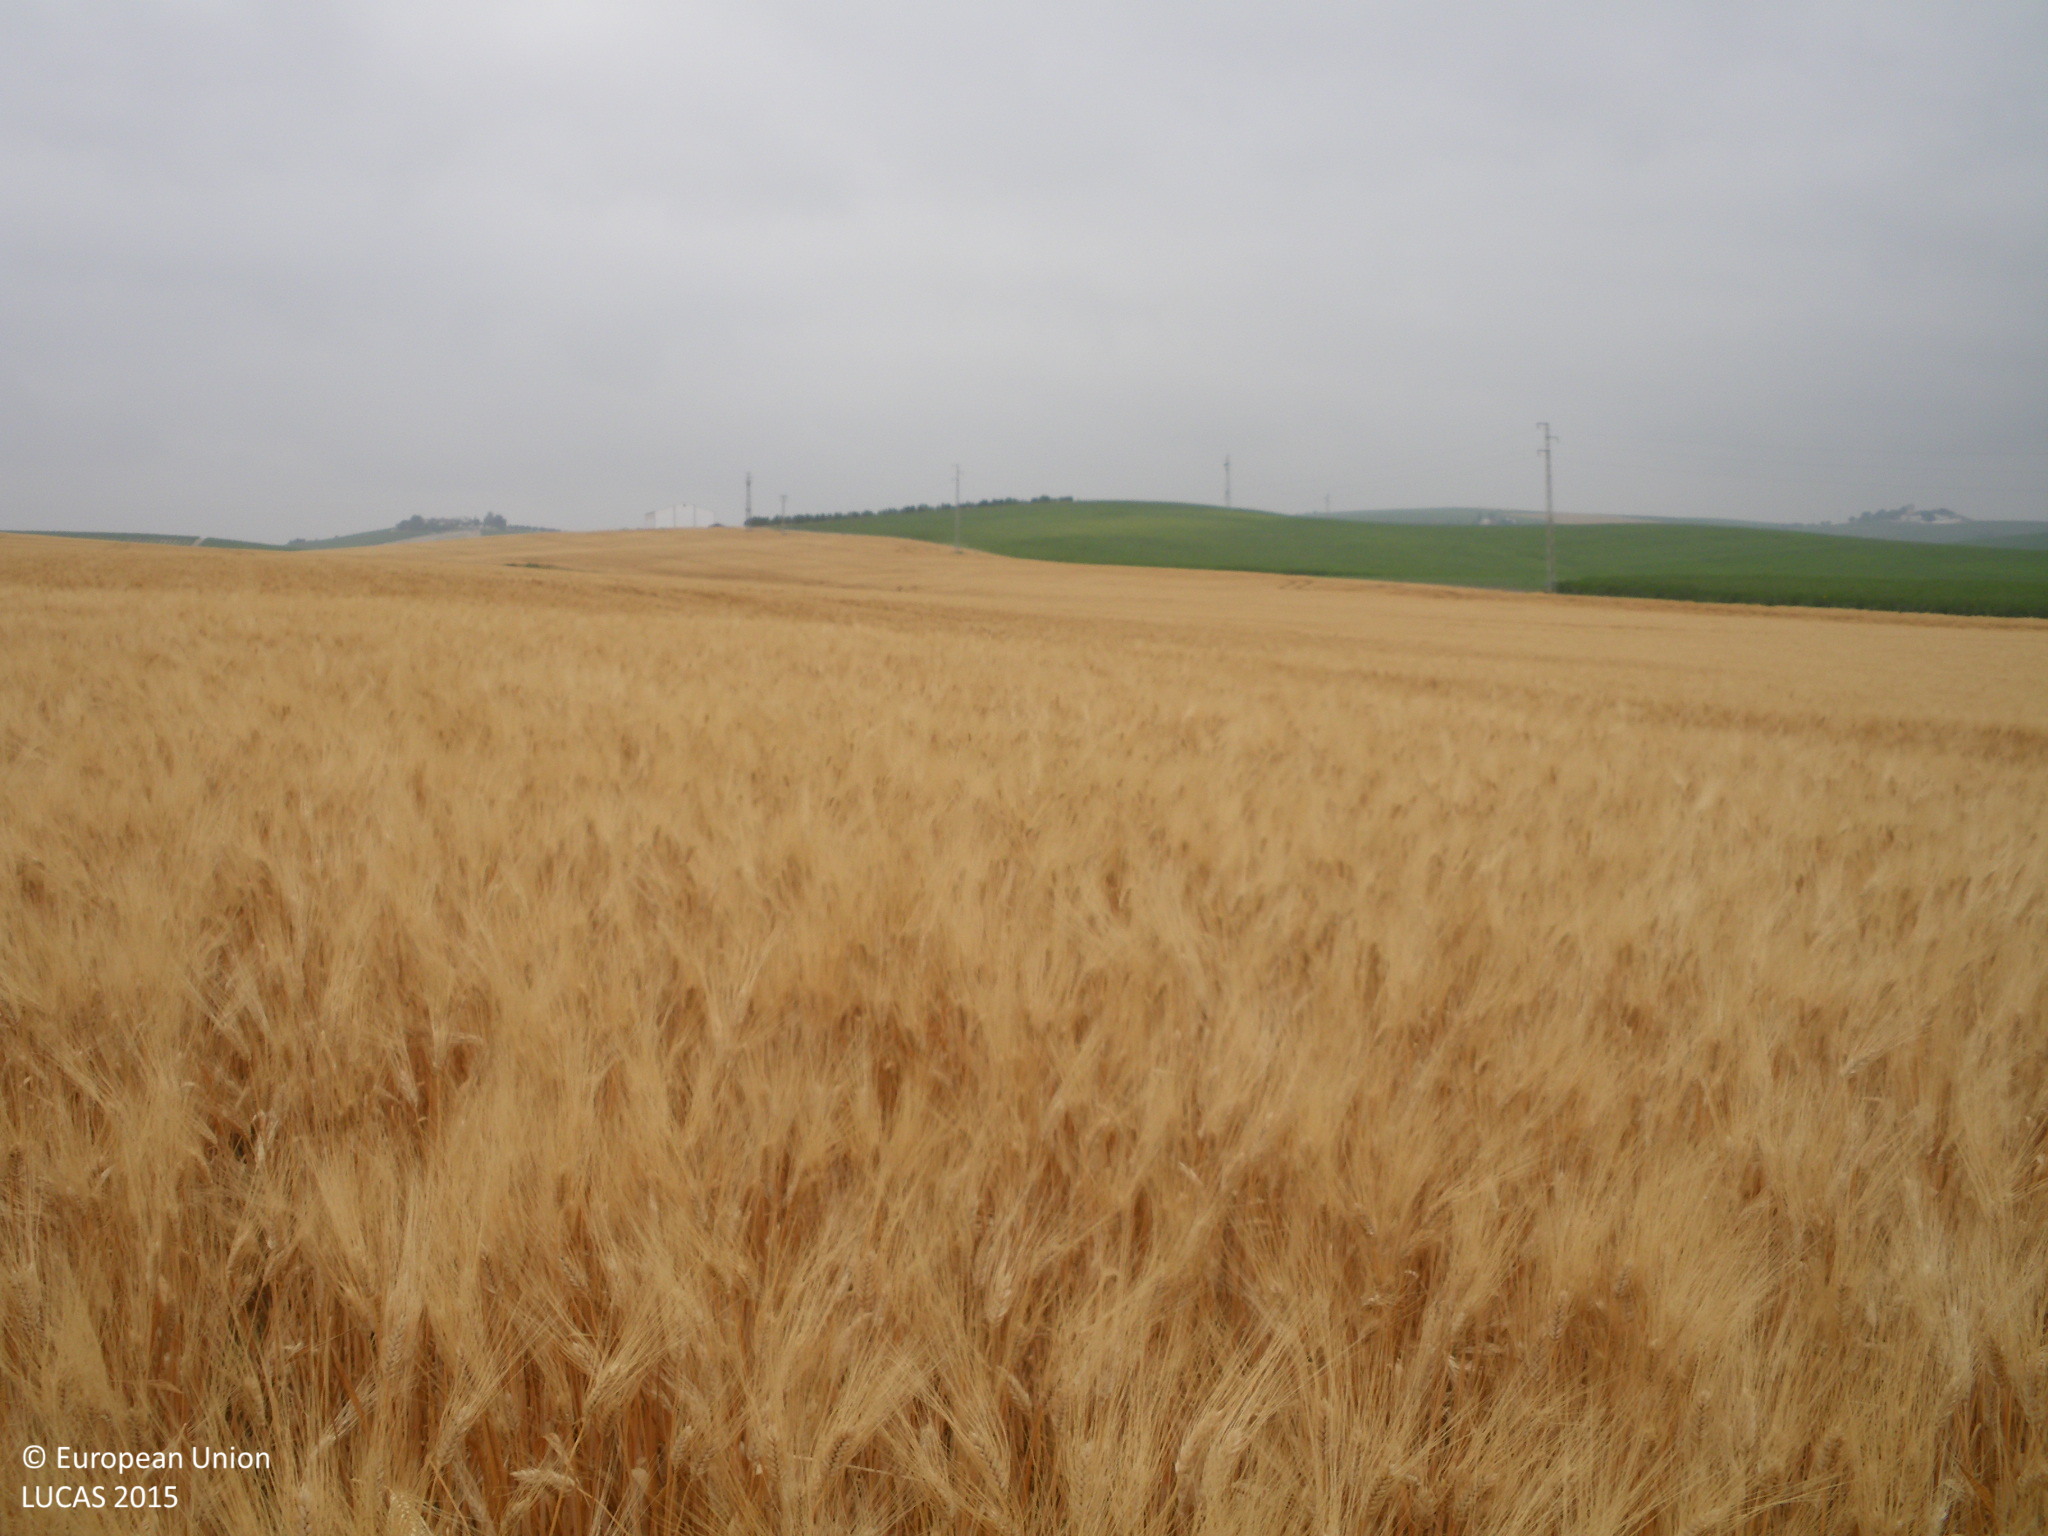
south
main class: Cropland
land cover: Durum wheat
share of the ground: > 75 %
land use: Agriculture (excluding fallow land and kitchen gardens)
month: May
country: ES
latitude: 36.7620
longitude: -6.1565
